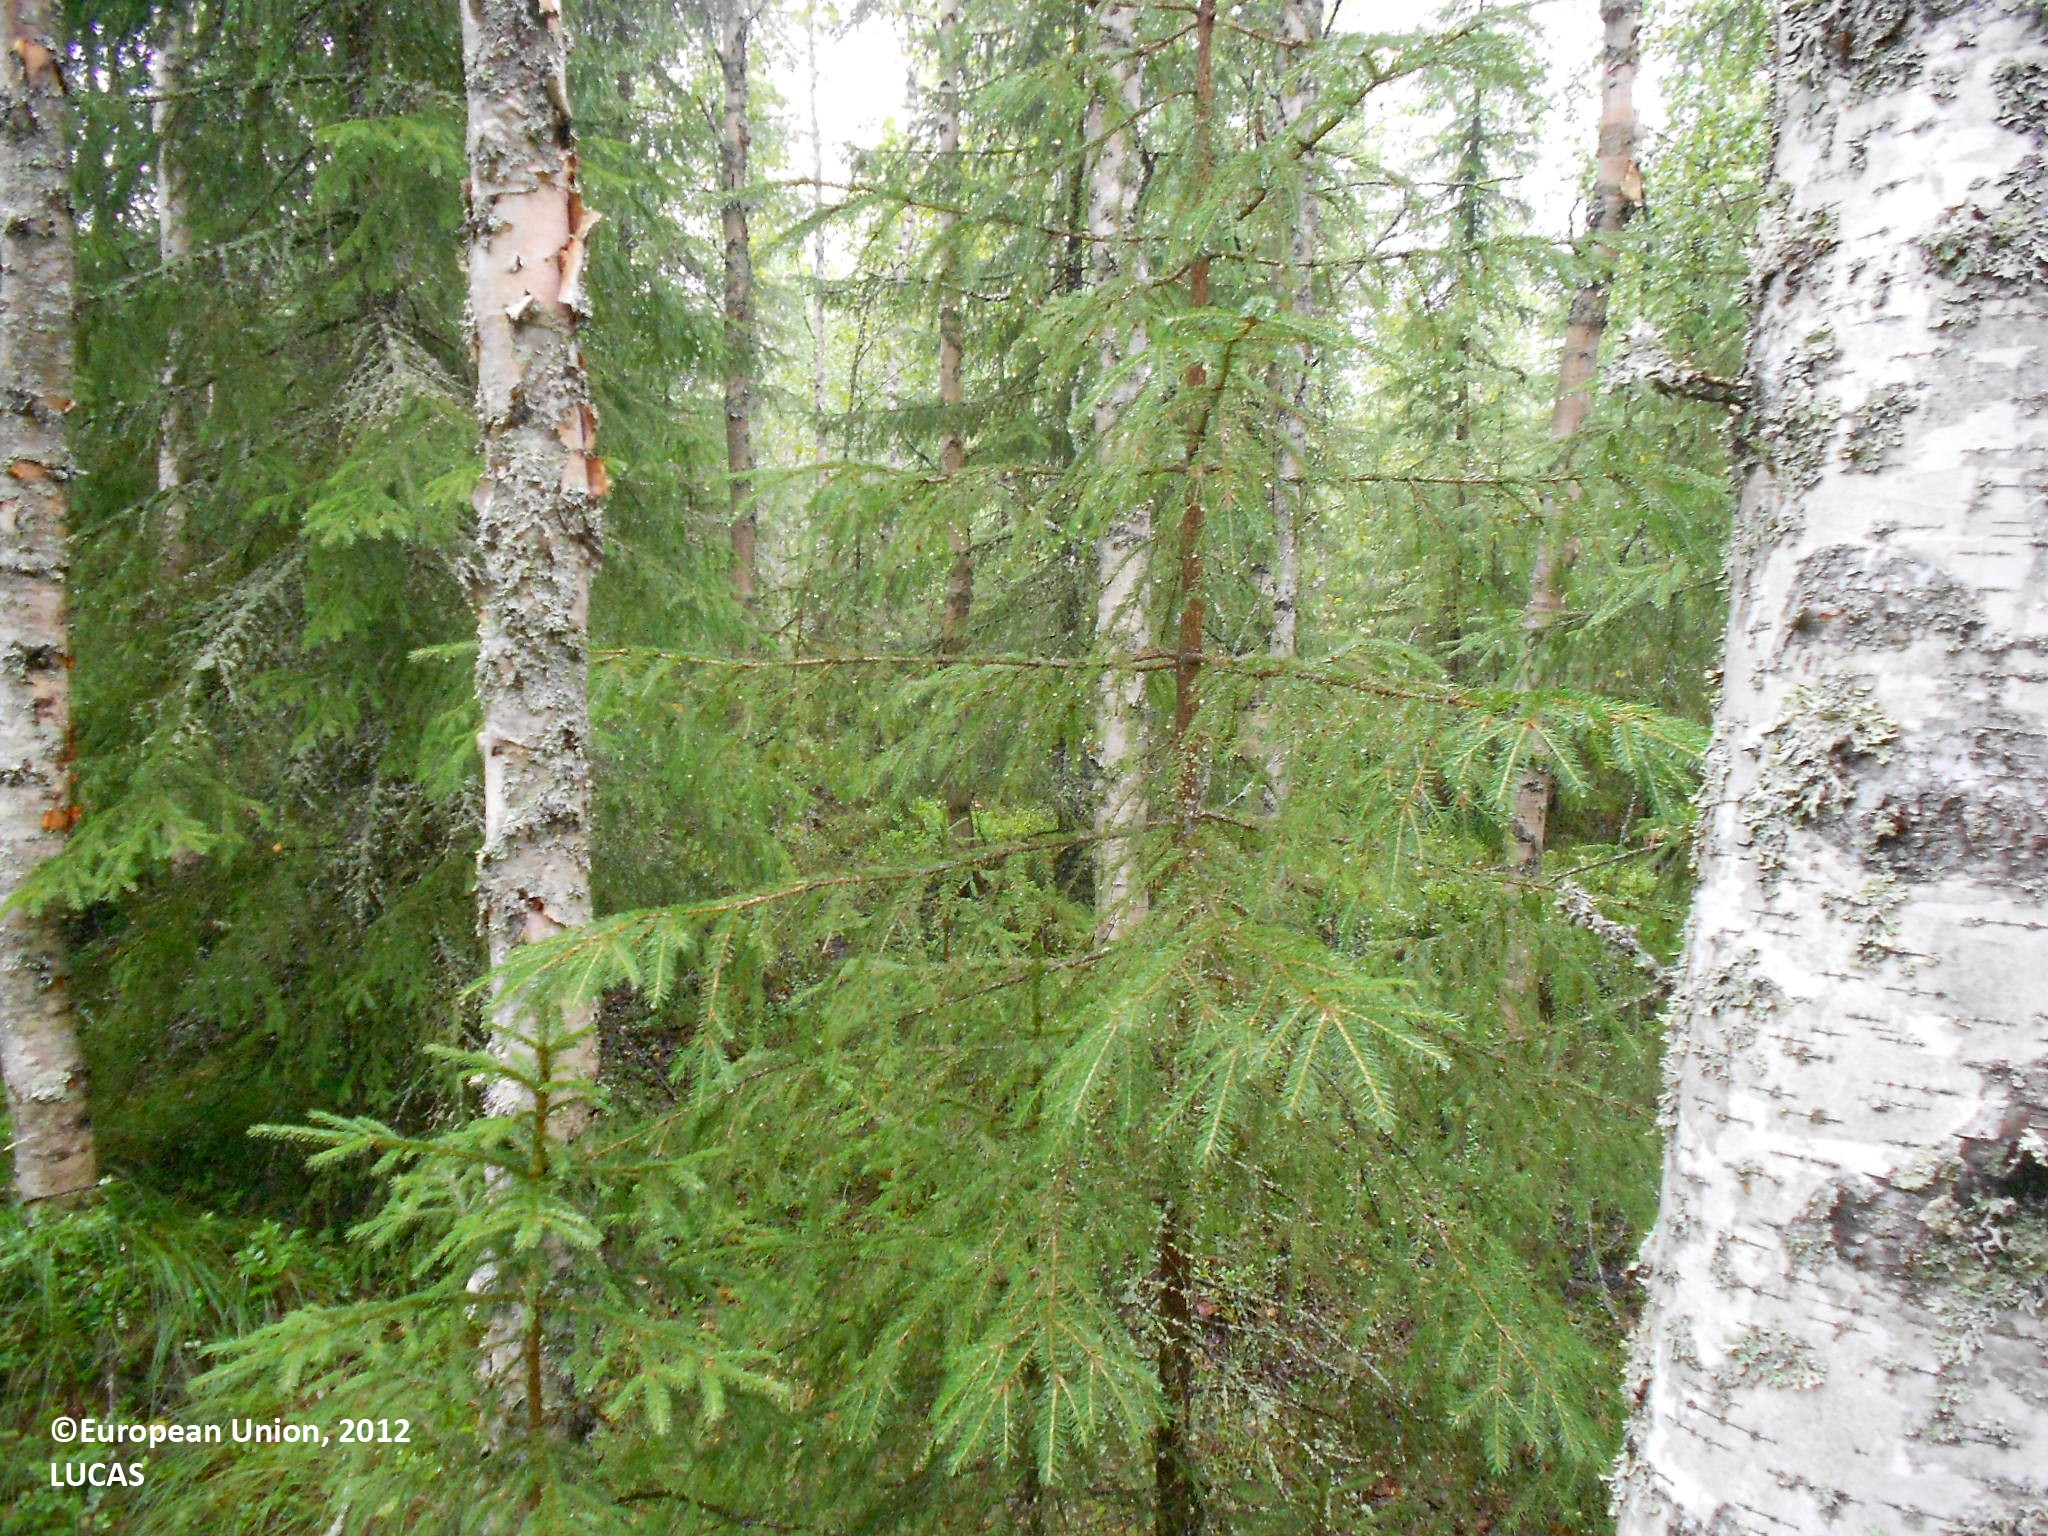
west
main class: Woodland
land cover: Spruce dominated mixed woodland
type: boreal forest
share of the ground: > 75 %
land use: Forestry
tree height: > 5 m
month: August
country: FI
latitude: 63.9689
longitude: 28.1644
